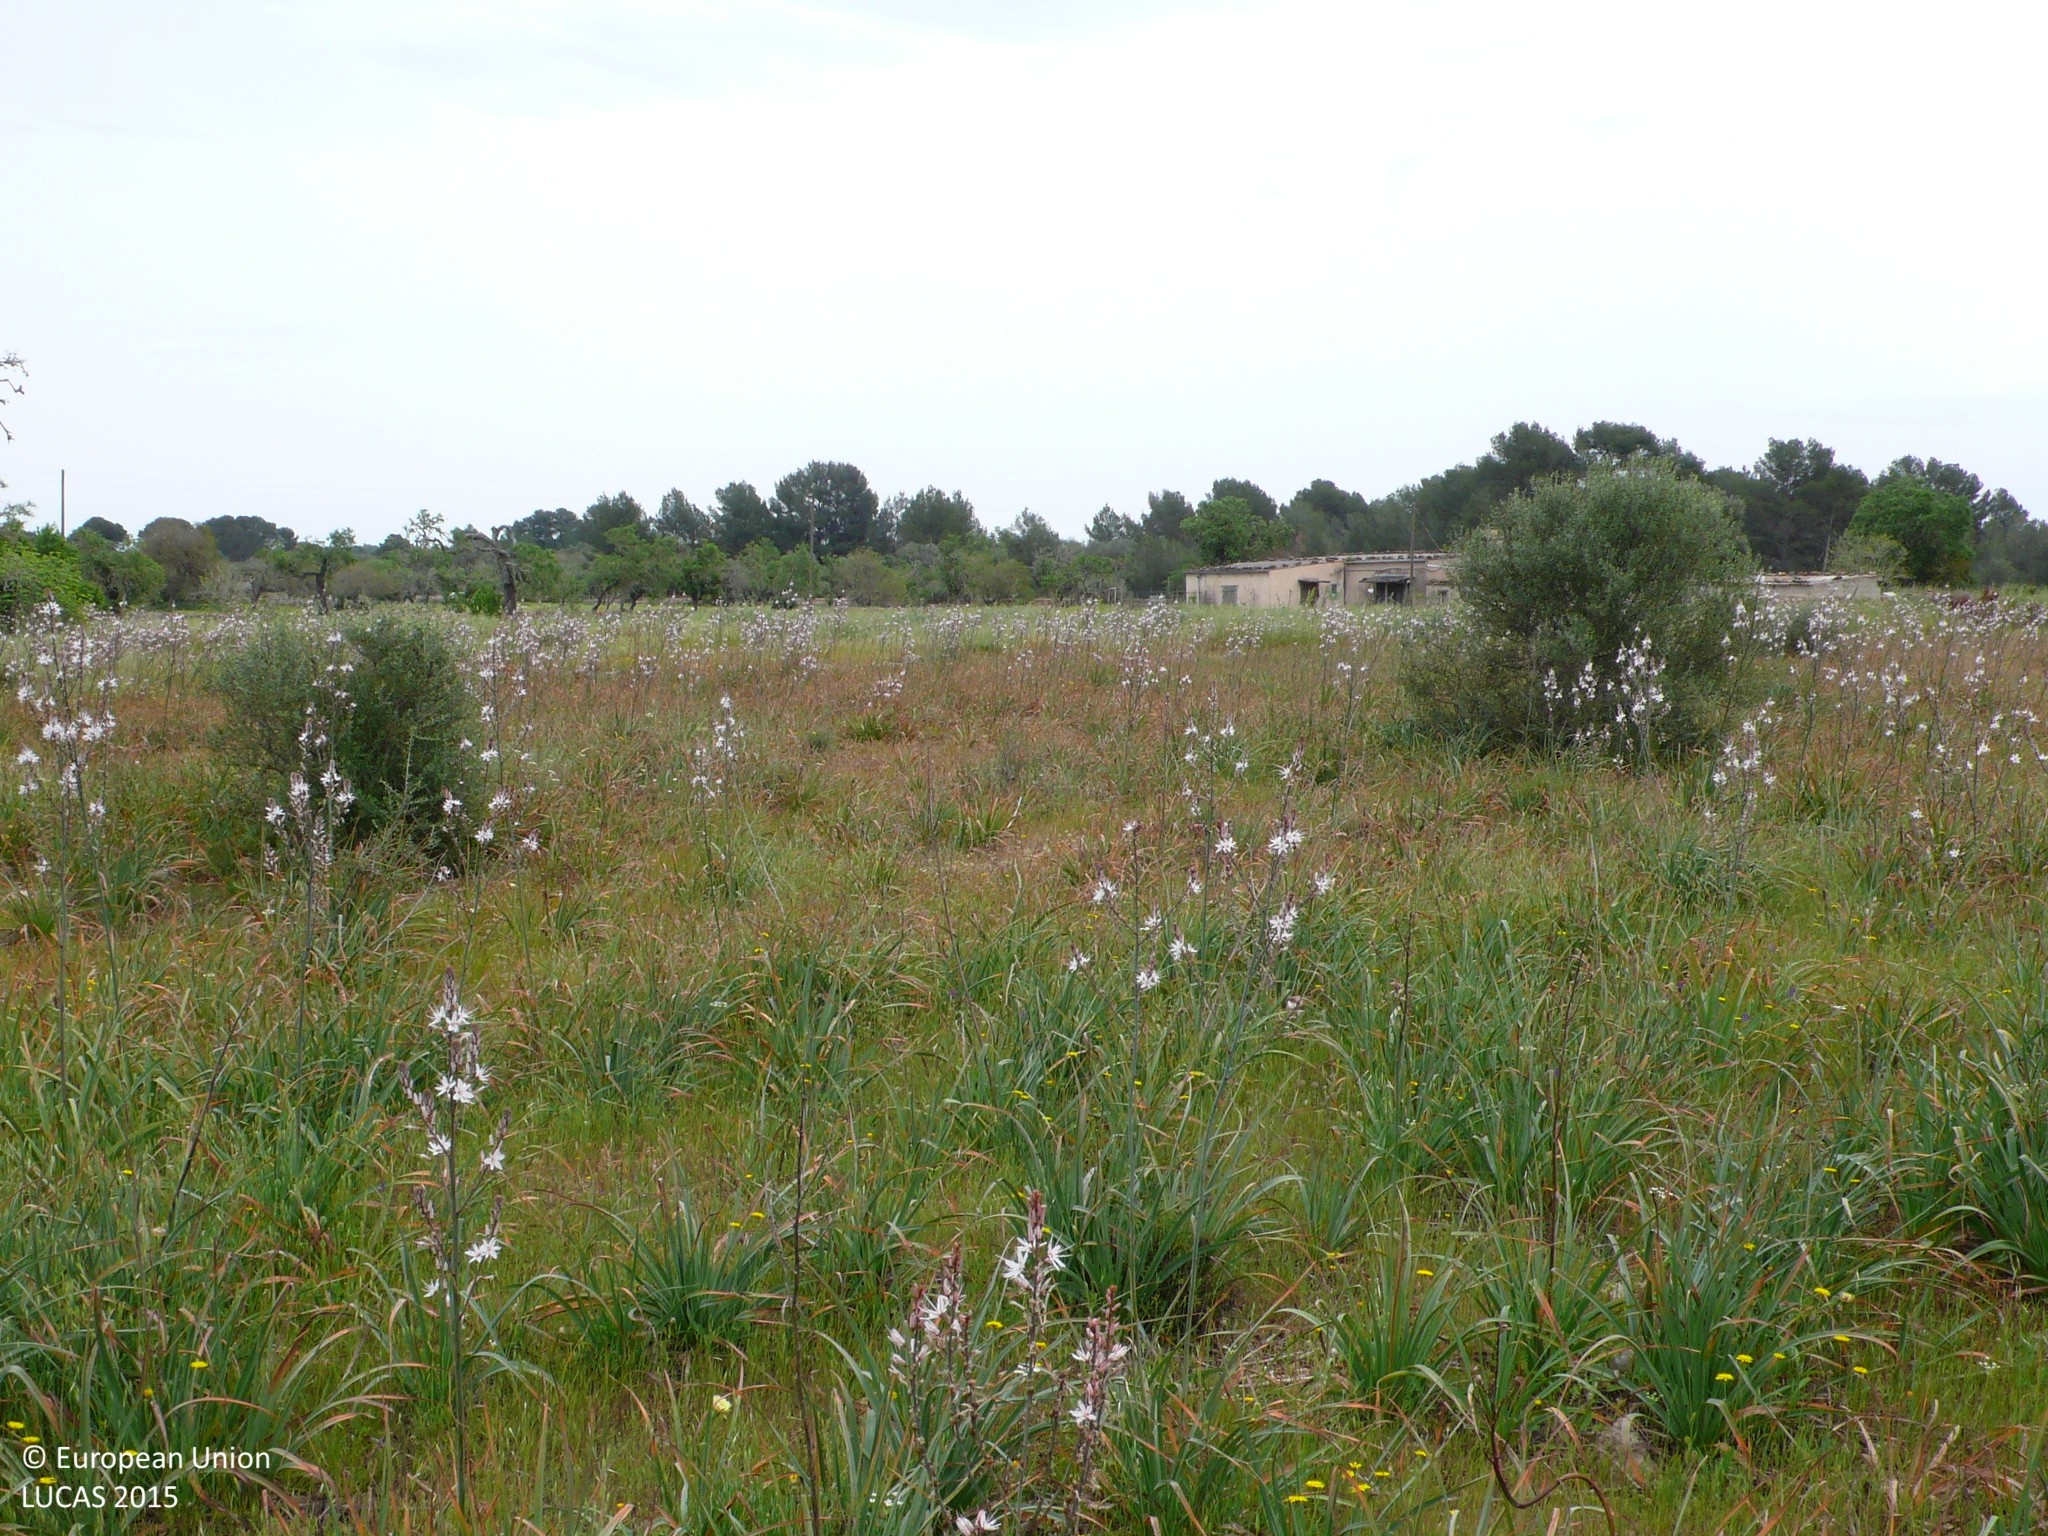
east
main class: Grassland
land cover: Grassland with sparse tree/shrub cover
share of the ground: > 75 %
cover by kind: herbaceous plants 75 %, consolidated bare surface 20 %, broadleaved forest trees 5 %
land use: Residential
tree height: < 5 m
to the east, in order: Grassland with sparse tree/shrub cover; Tracks; Fences; Grassland with sparse tree/shrub cover; Tracks; Grassland with sparse tree/shrub cover; Electric lines; Grassland with sparse tree/shrub cover; Dry stone walls; Nuts trees; Dry stone walls; Grassland with sparse tree/shrub cover
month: April
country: ES
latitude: 39.5898
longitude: 2.8692
